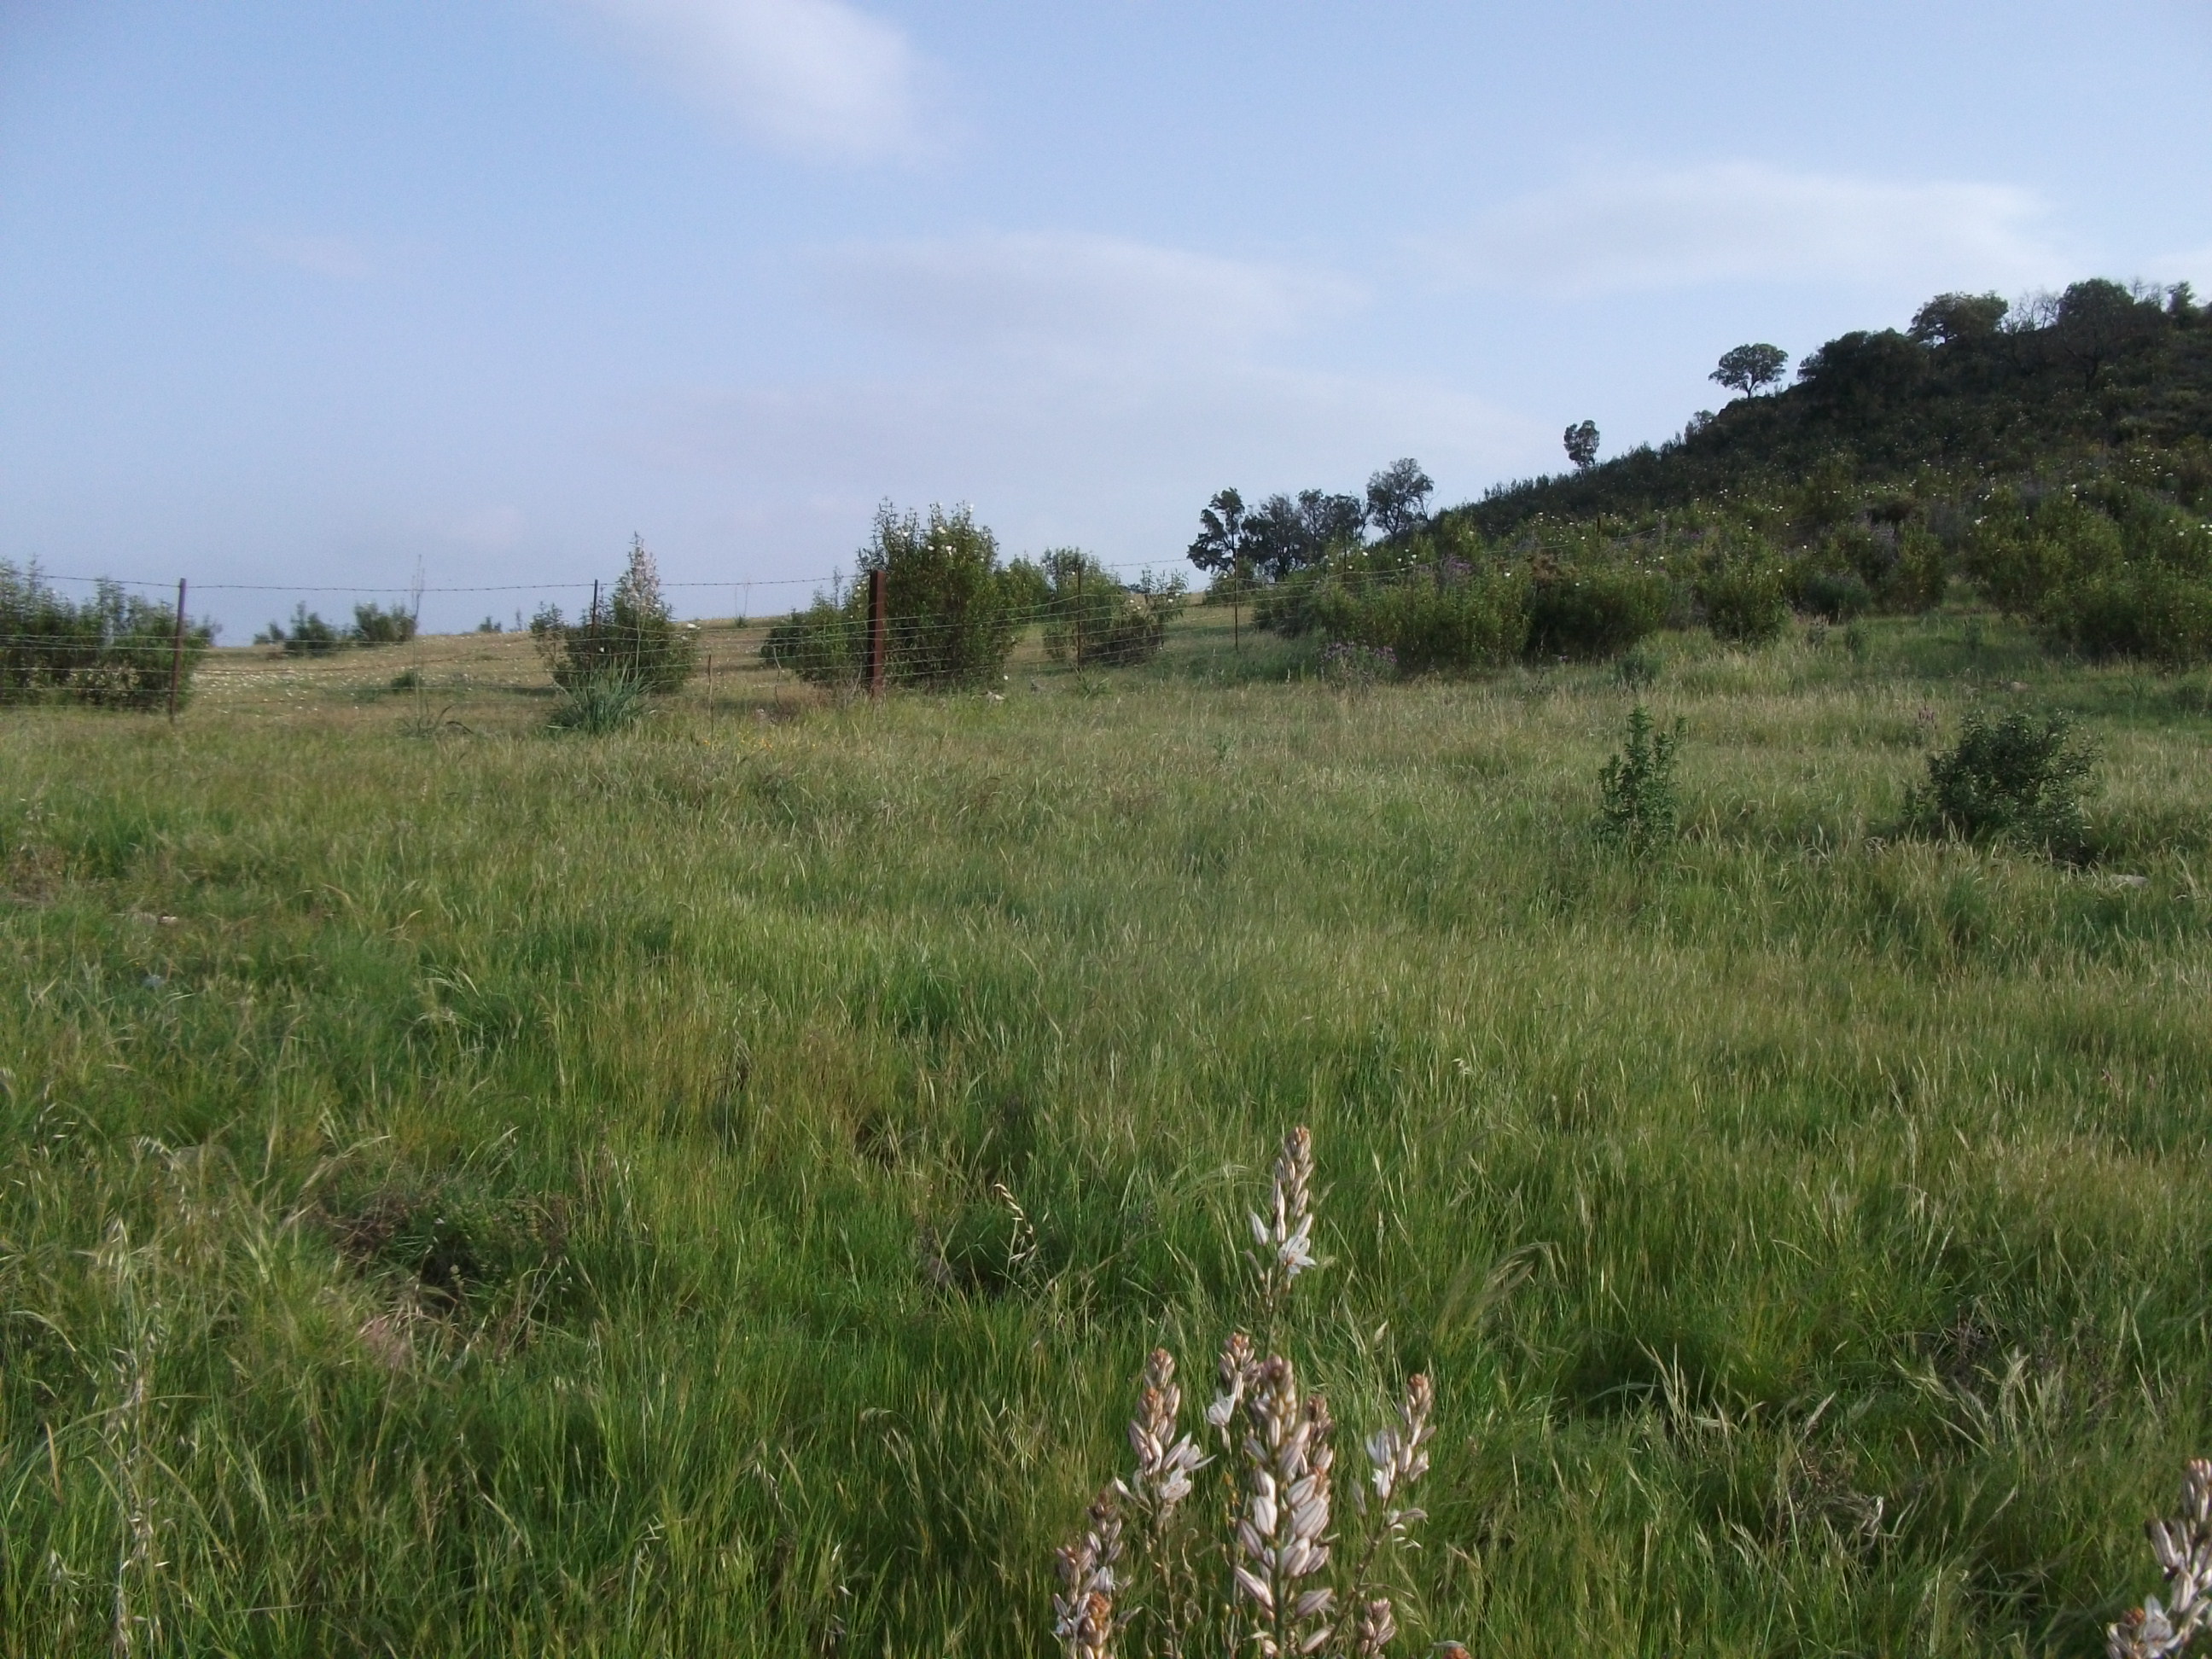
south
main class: Grassland
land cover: Grassland without tree/shrub cover
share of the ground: > 75 %
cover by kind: herbaceous plants 95 %, shrubs 5 %
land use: Agriculture (excluding fallow land and kitchen gardens)
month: April
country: ES
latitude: 37.7559
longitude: -6.6943
